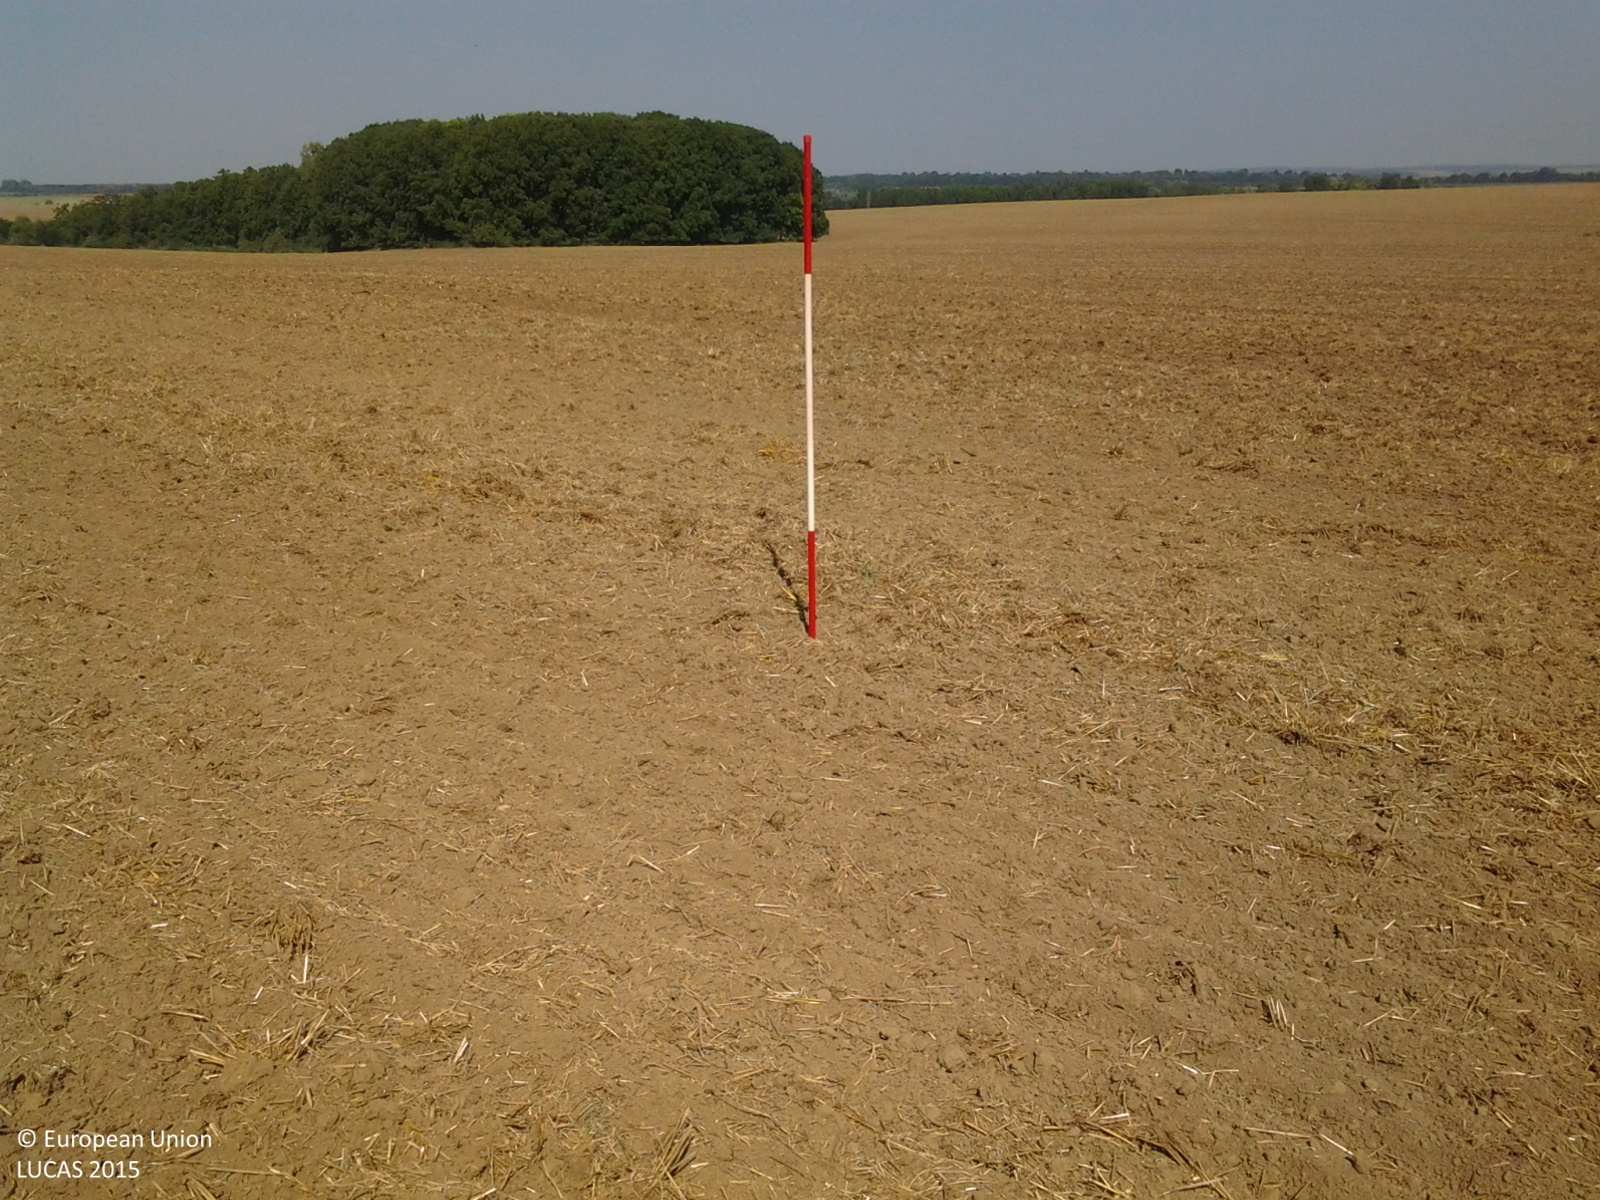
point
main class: Cropland
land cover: Common wheat
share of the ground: < 10 %
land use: Agriculture (excluding fallow land and kitchen gardens)
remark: Harvested field
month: August
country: HU
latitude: 46.4743
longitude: 18.1482
